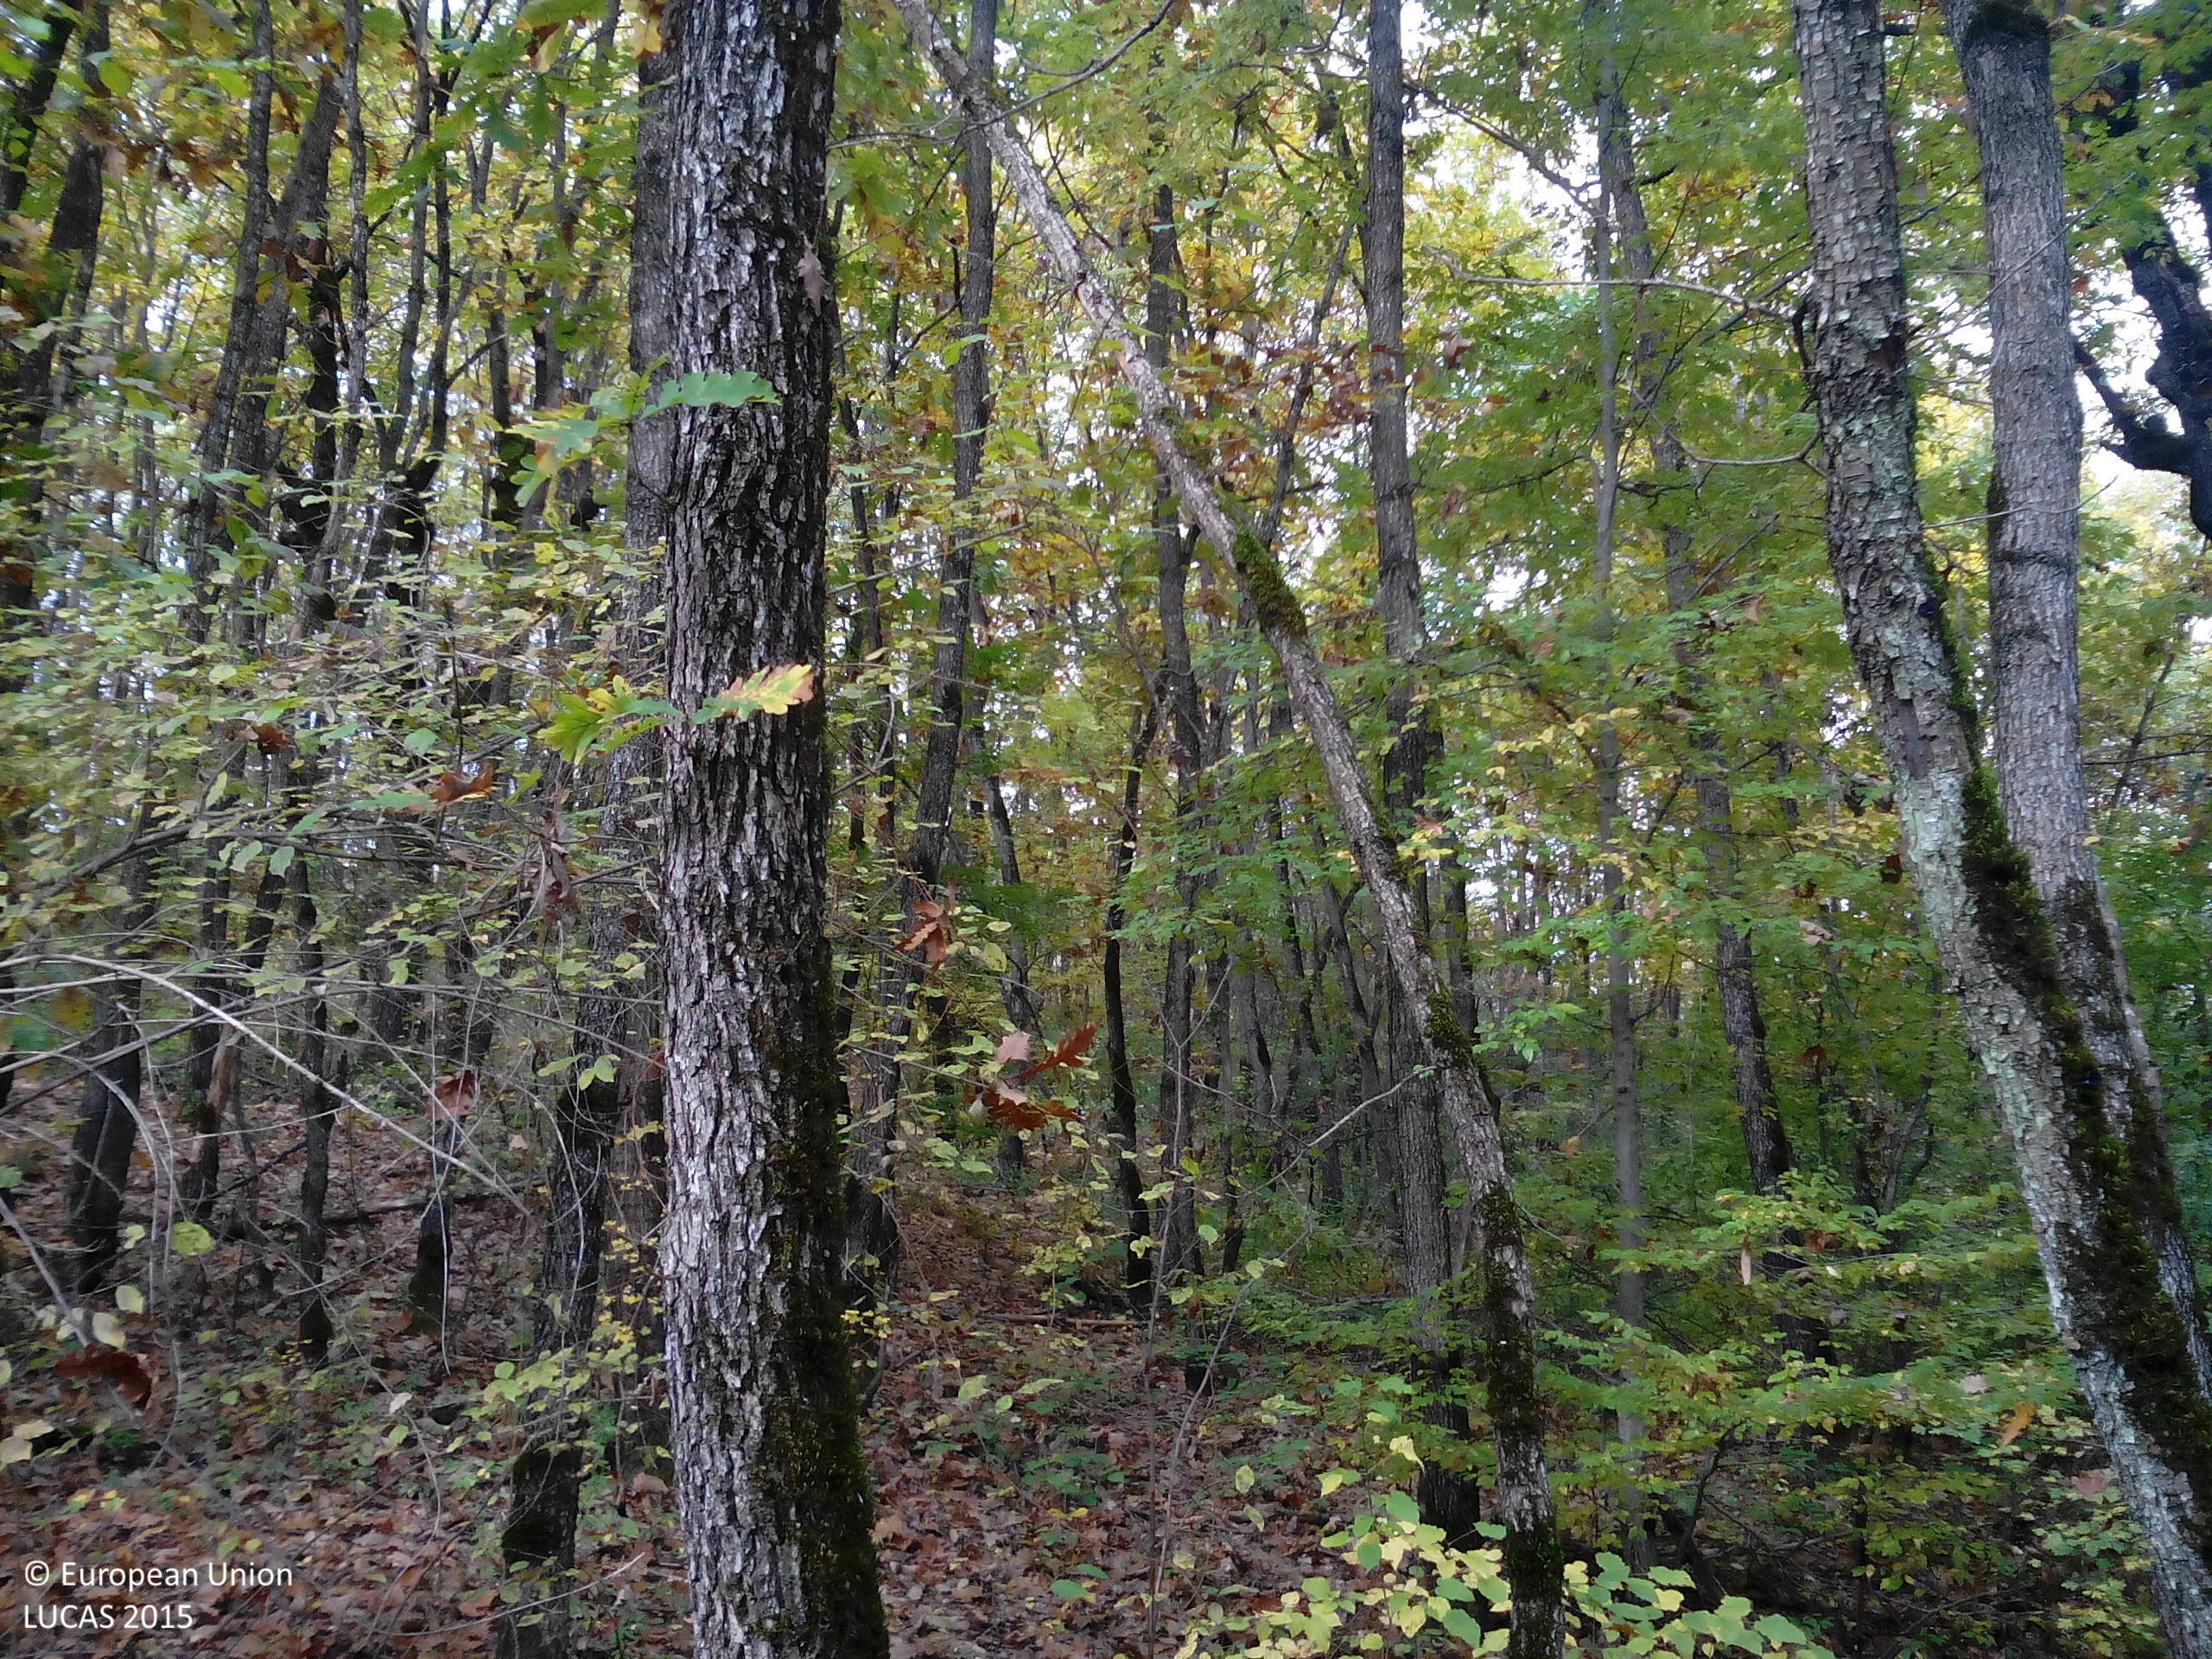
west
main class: Woodland
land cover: Broadleaved woodland
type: acidophilous oak and oak-birch forest
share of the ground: > 75 %
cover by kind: broadleaved forest trees 95 %, shrubs 5 %
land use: Forestry
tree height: > 5 m
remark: Clear cut
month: October
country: BG
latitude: 42.9558
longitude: 24.0093
